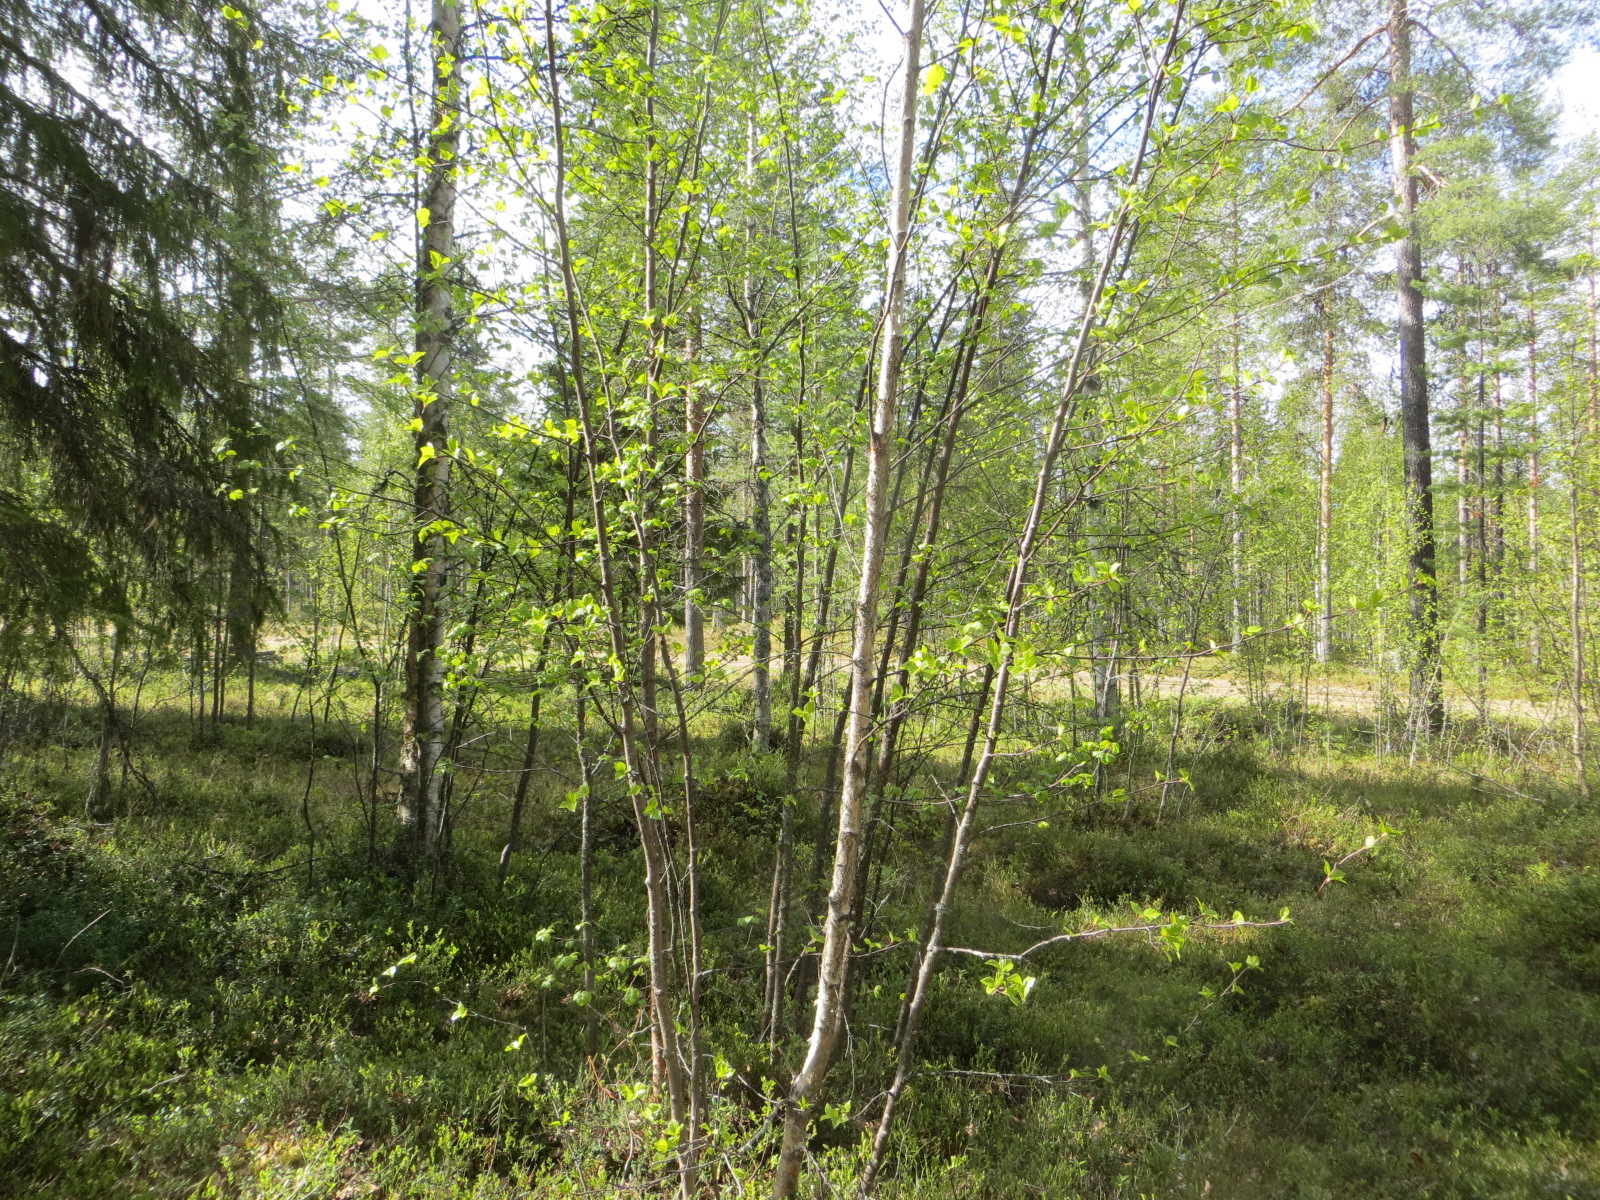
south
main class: Woodland
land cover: Pine dominated mixed woodland
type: boreal forest
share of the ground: 50 - 75 %
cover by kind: coniferous forest trees 50 %, shrubs 30 %, broadleaved forest trees 20 %
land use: Forestry
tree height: > 5 m
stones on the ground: 25 - 50 %
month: June
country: FI
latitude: 67.6149
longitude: 25.2668
